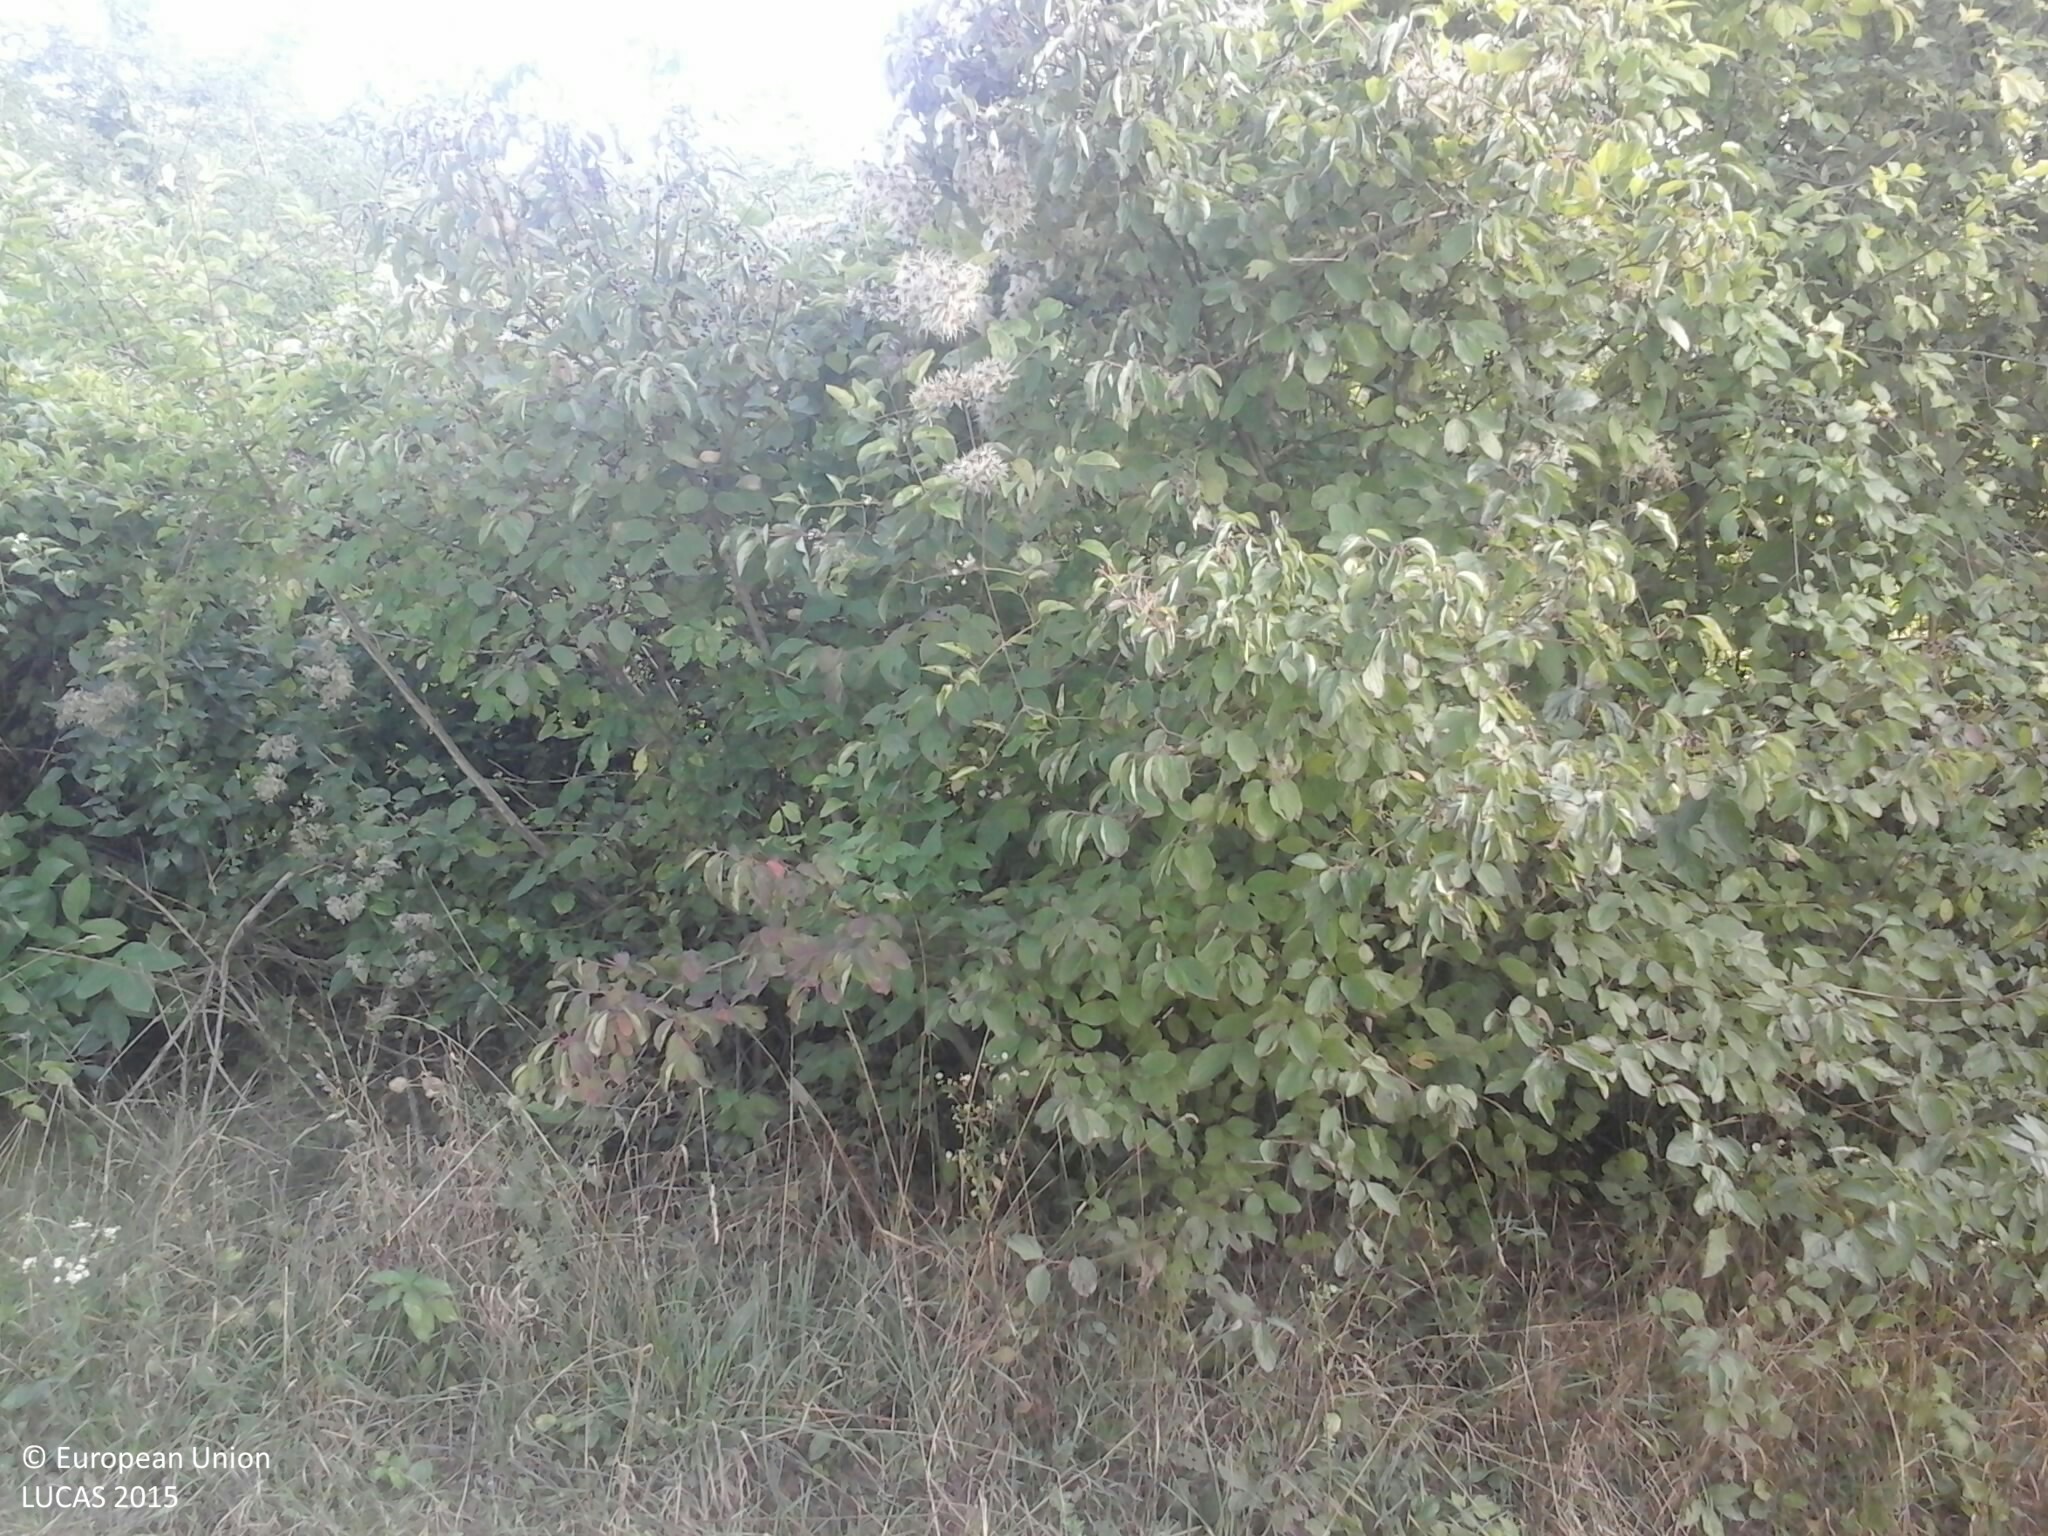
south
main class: Grassland
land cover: Spontaneously vegetated surfaces
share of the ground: > 75 %
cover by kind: herbaceous plants 100 %
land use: Residential
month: August
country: HU
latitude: 48.0254
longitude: 19.3414
